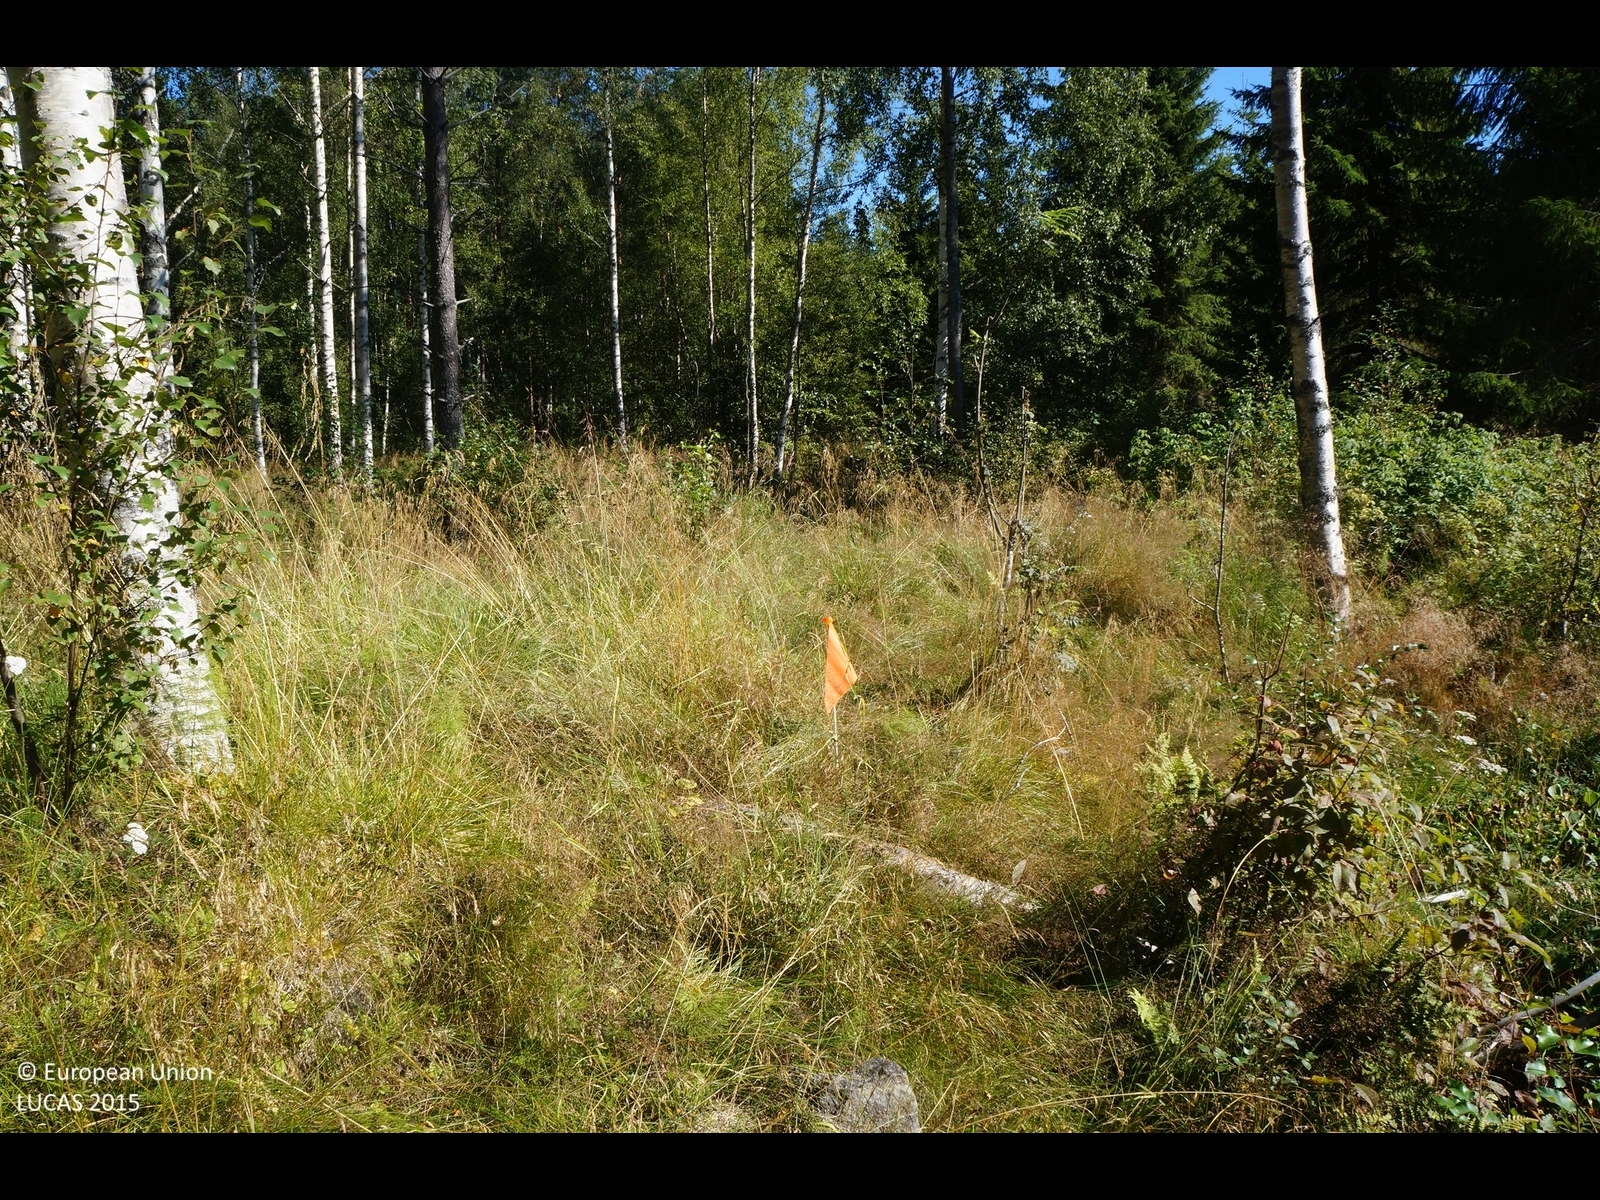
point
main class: Woodland
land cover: Broadleaved woodland
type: boreal forest
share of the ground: 25 - 50 %
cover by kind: herbaceous plants 50 %, broadleaved forest trees 30 %, shrubs 10 %, coniferous forest trees 5 %, lichens and mosses 5 %
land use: Forestry
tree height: > 5 m
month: August
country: FI
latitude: 63.8234
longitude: 22.7874
